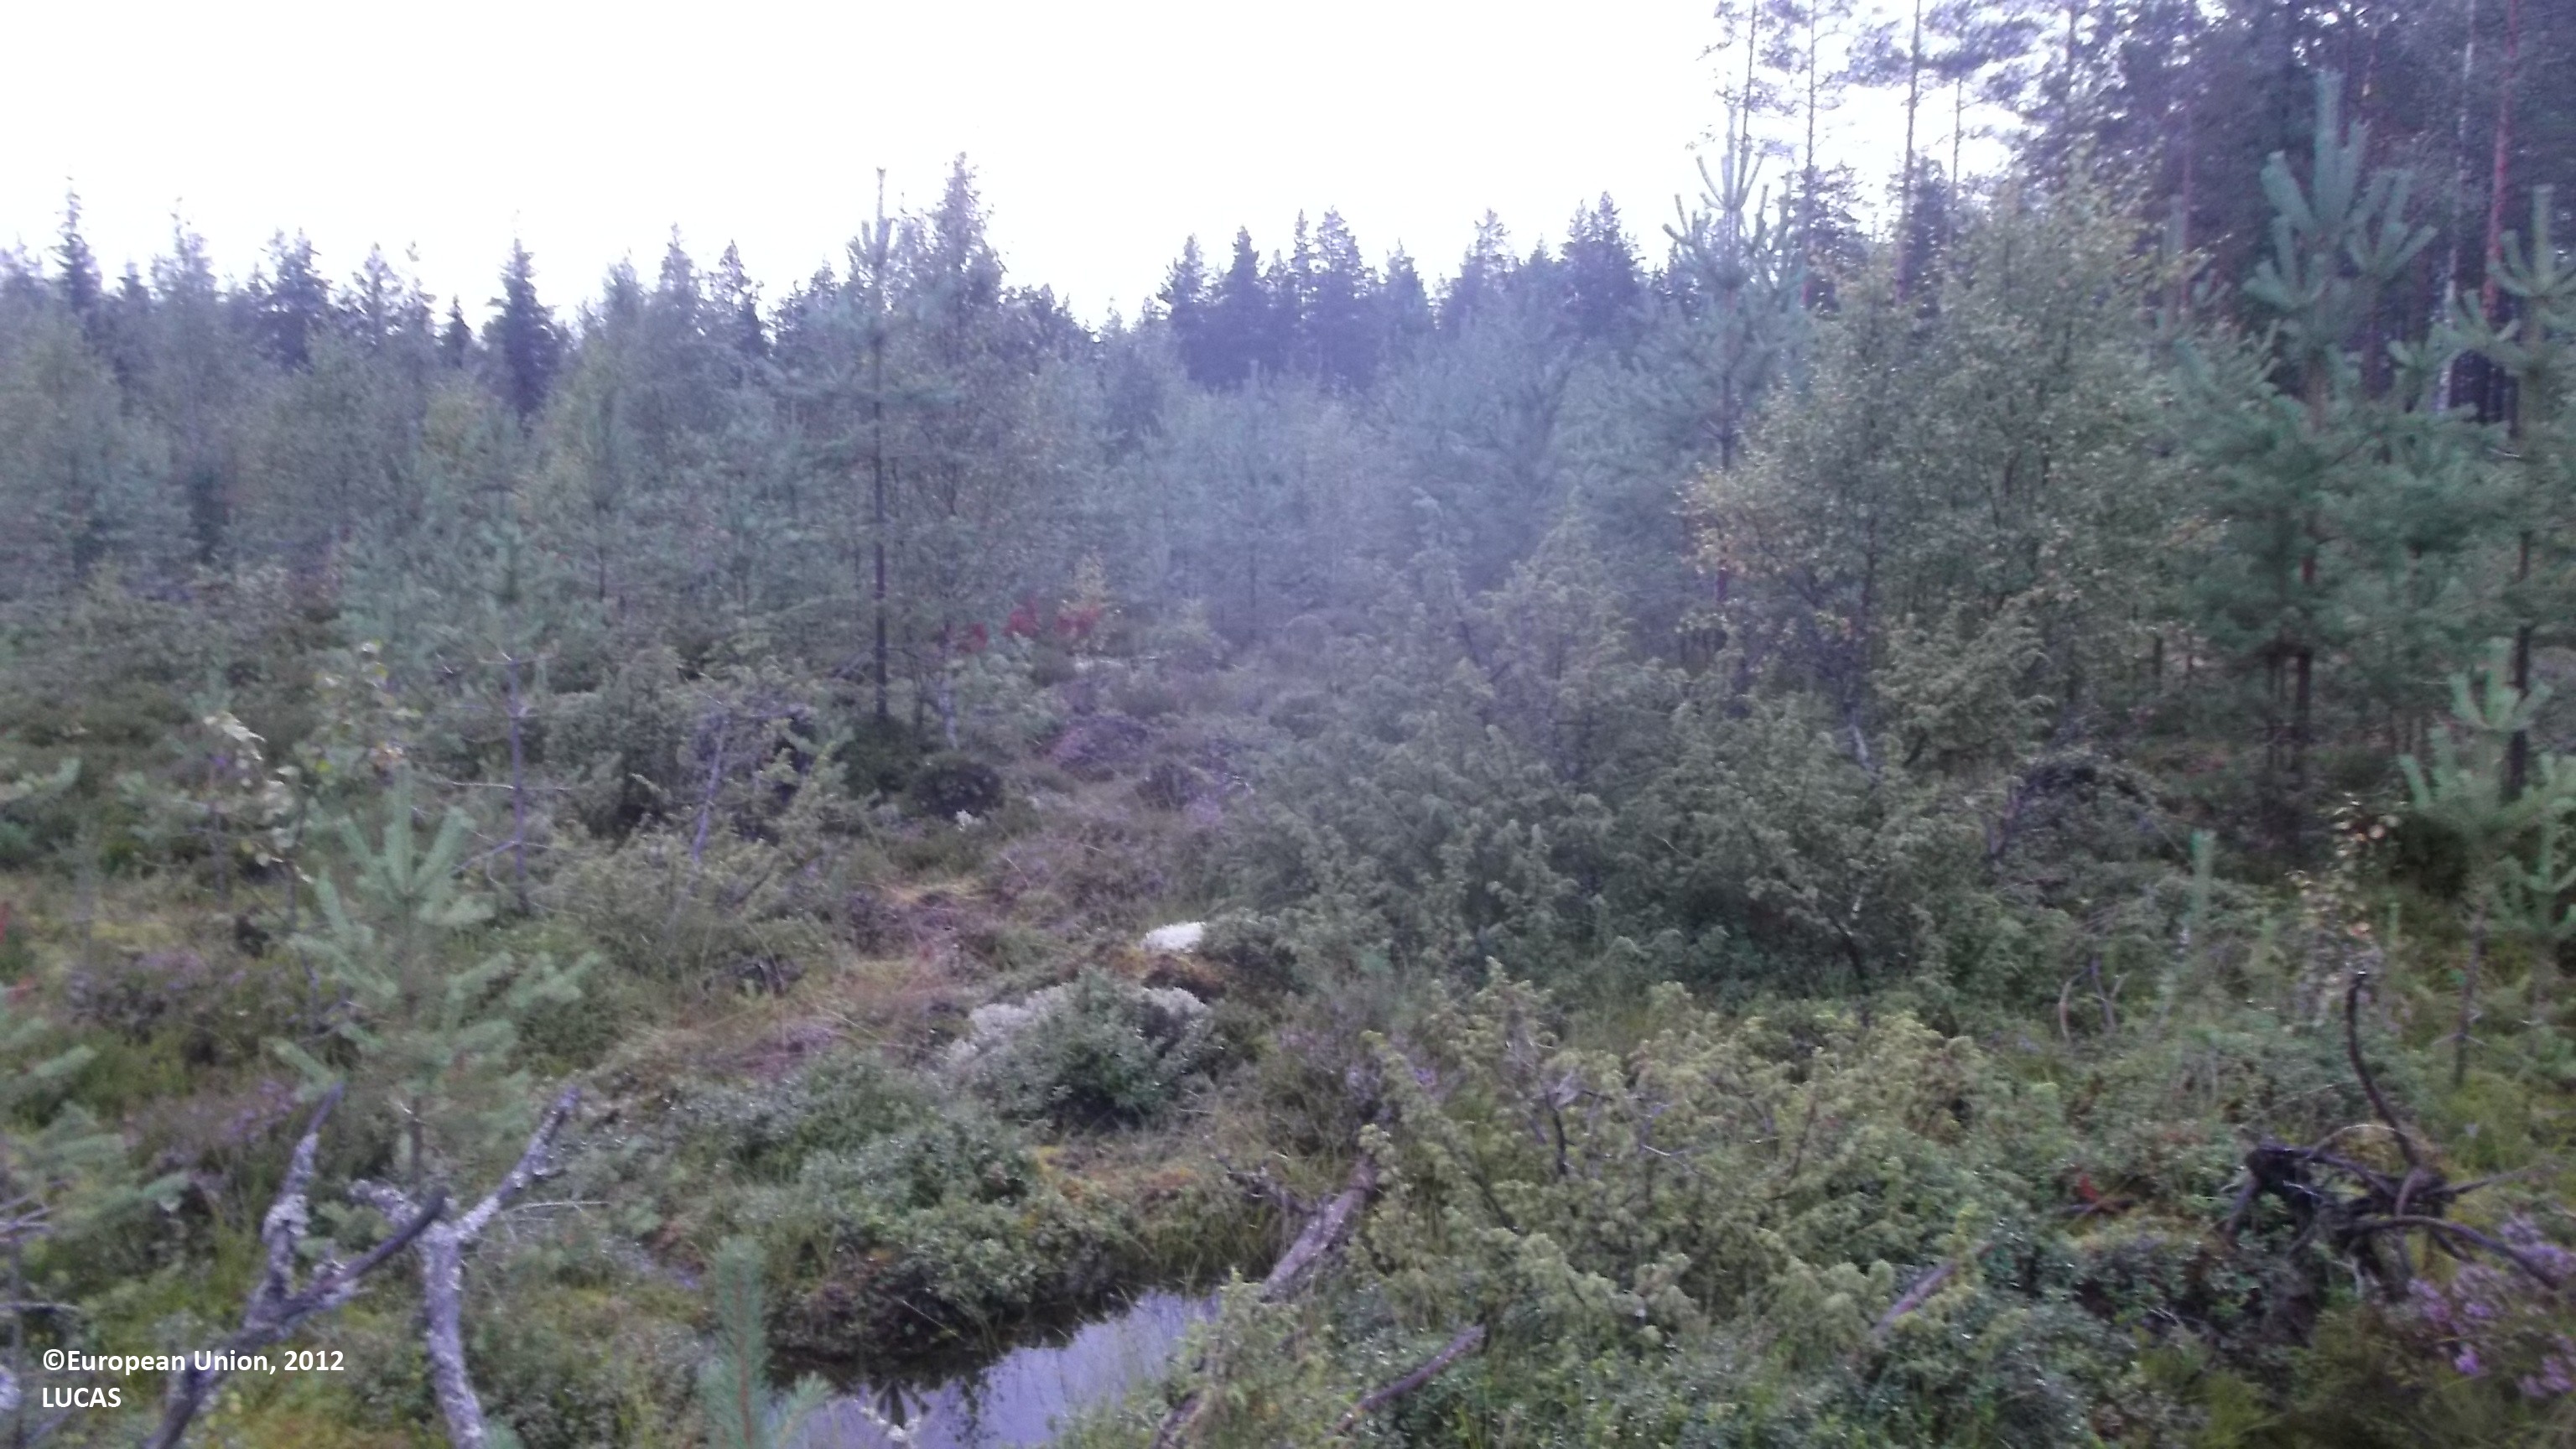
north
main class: Woodland
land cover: Other mixed woodland
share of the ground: < 10 %
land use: Forestry
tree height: < 5 m
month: August
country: FI
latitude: 63.1976
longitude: 24.4539
